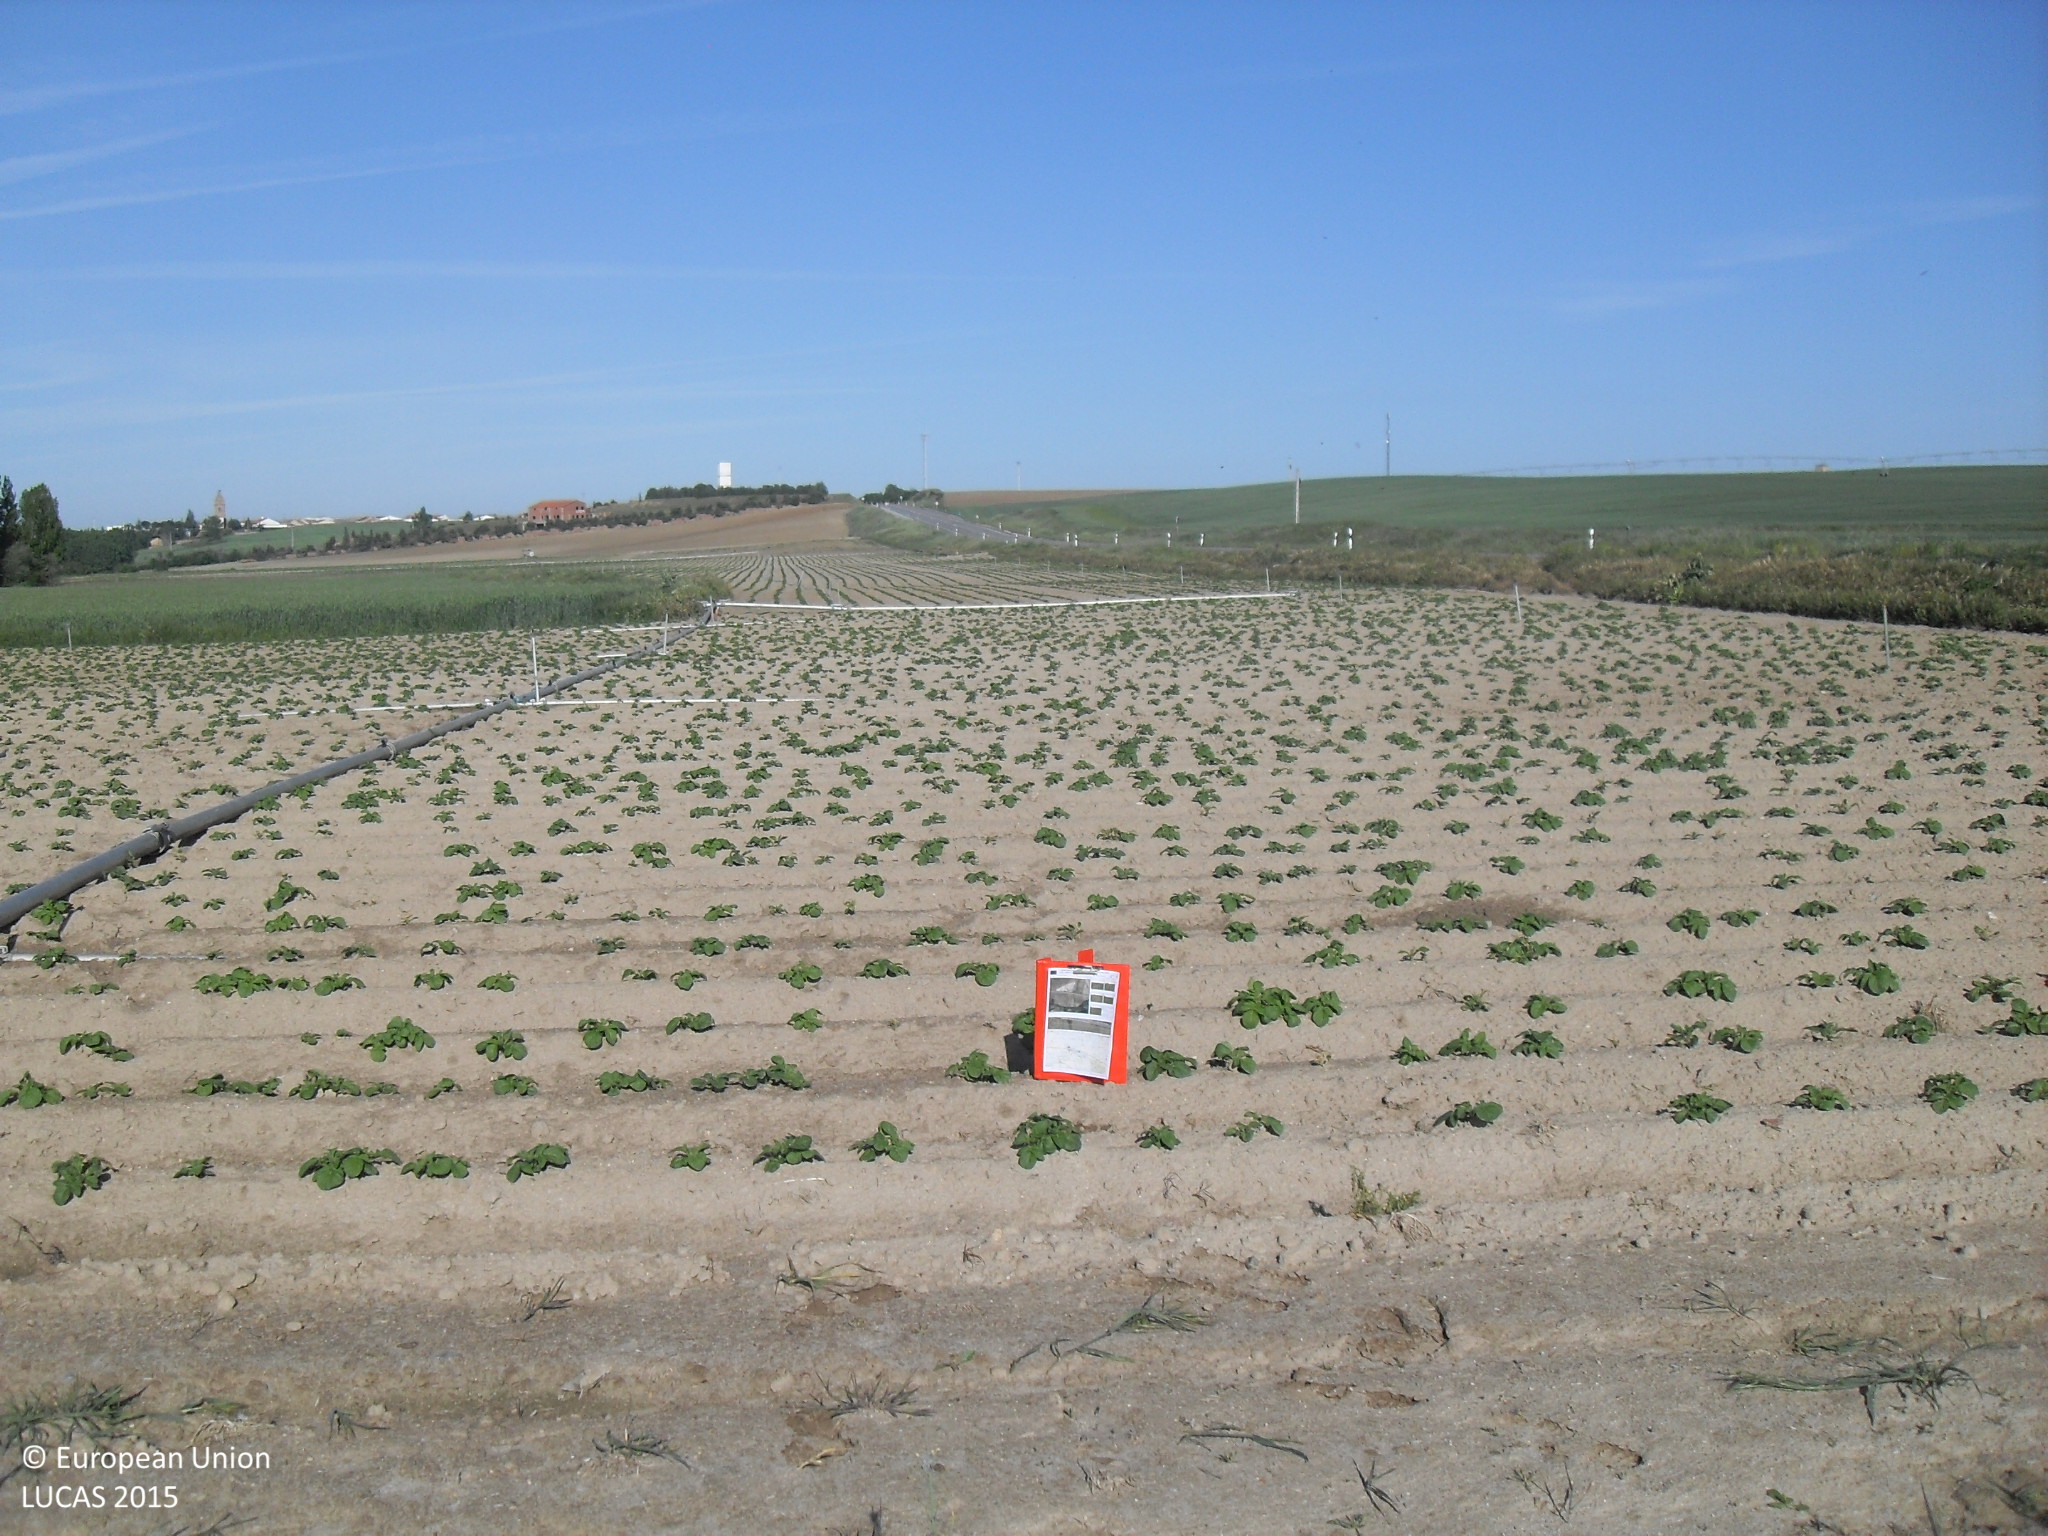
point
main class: Cropland
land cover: Potatoes
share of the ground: > 75 %
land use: Agriculture (excluding fallow land and kitchen gardens)
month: May
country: ES
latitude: 40.9282
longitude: -5.3305
